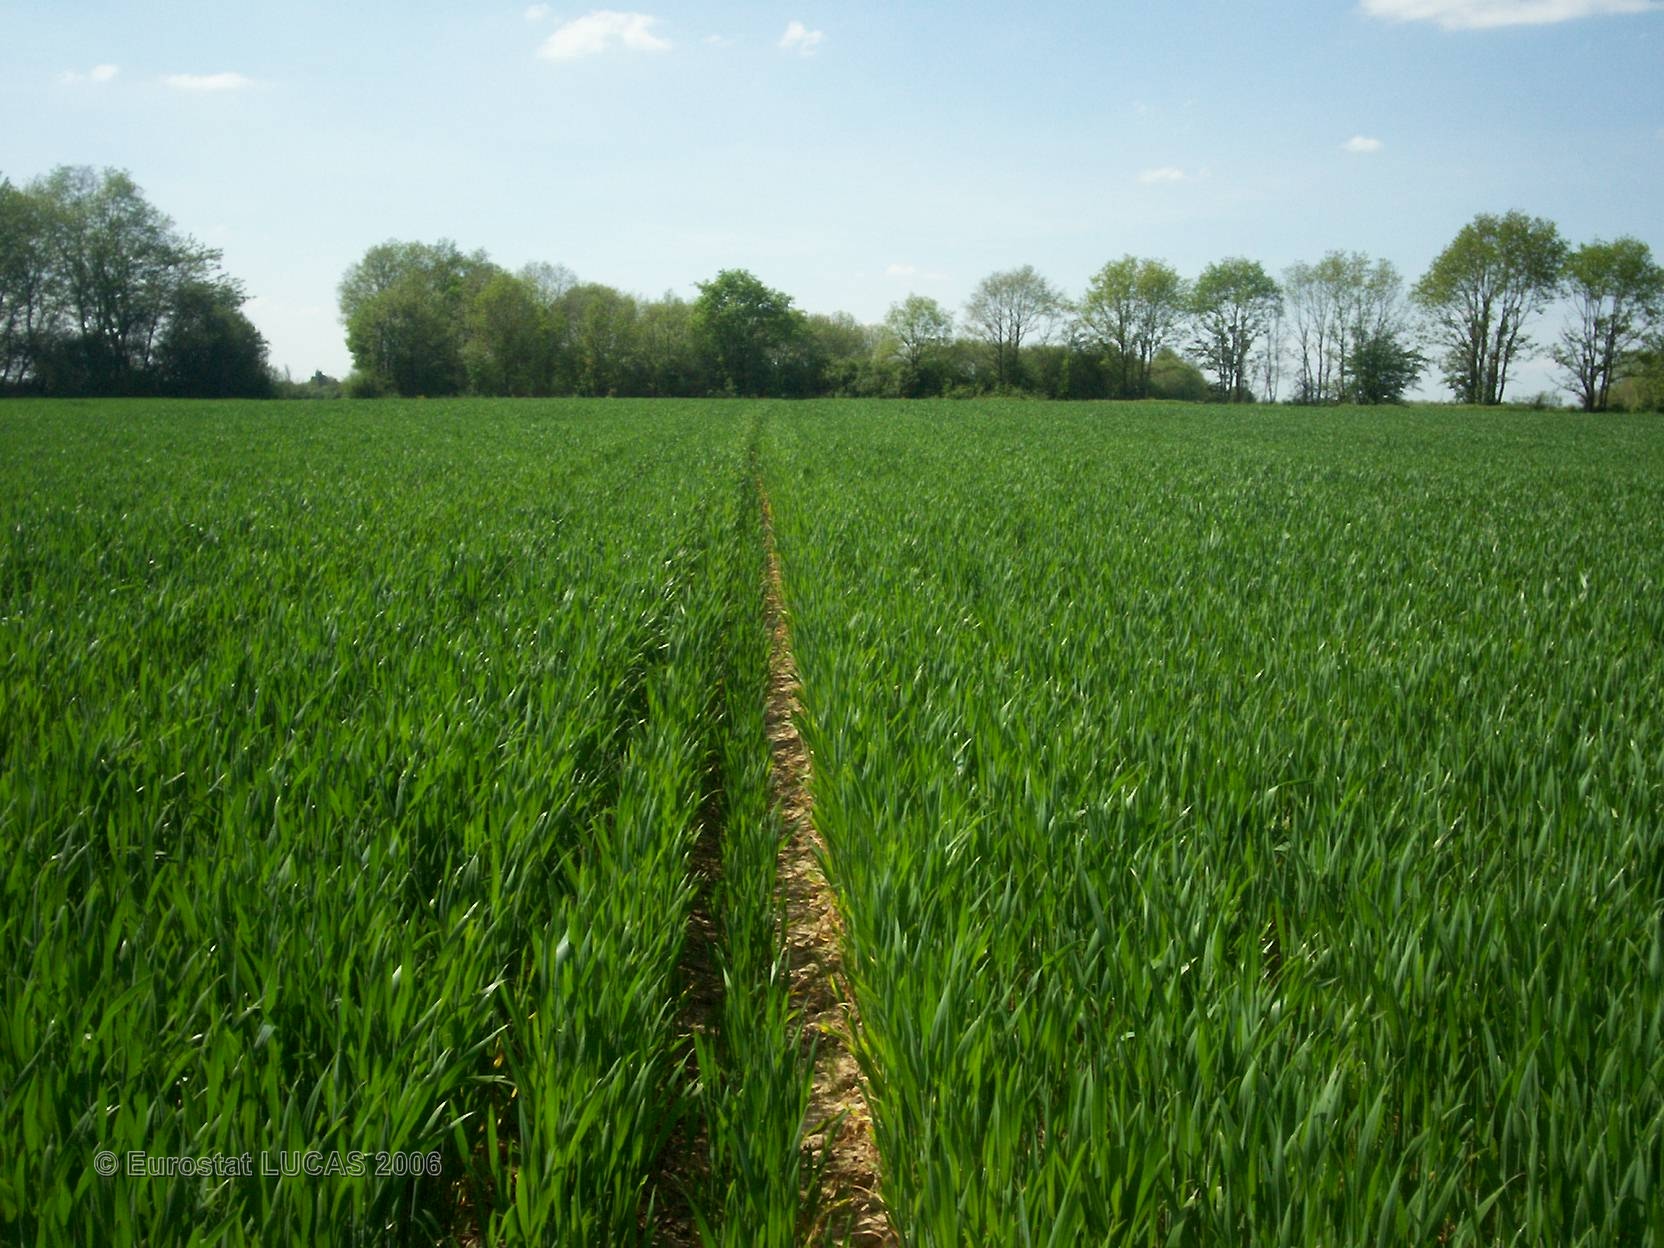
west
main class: Cropland
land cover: Common wheat
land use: Agriculture (excluding fallow land and kitchen gardens)
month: May
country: FR
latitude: 46.5061
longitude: 0.4823
